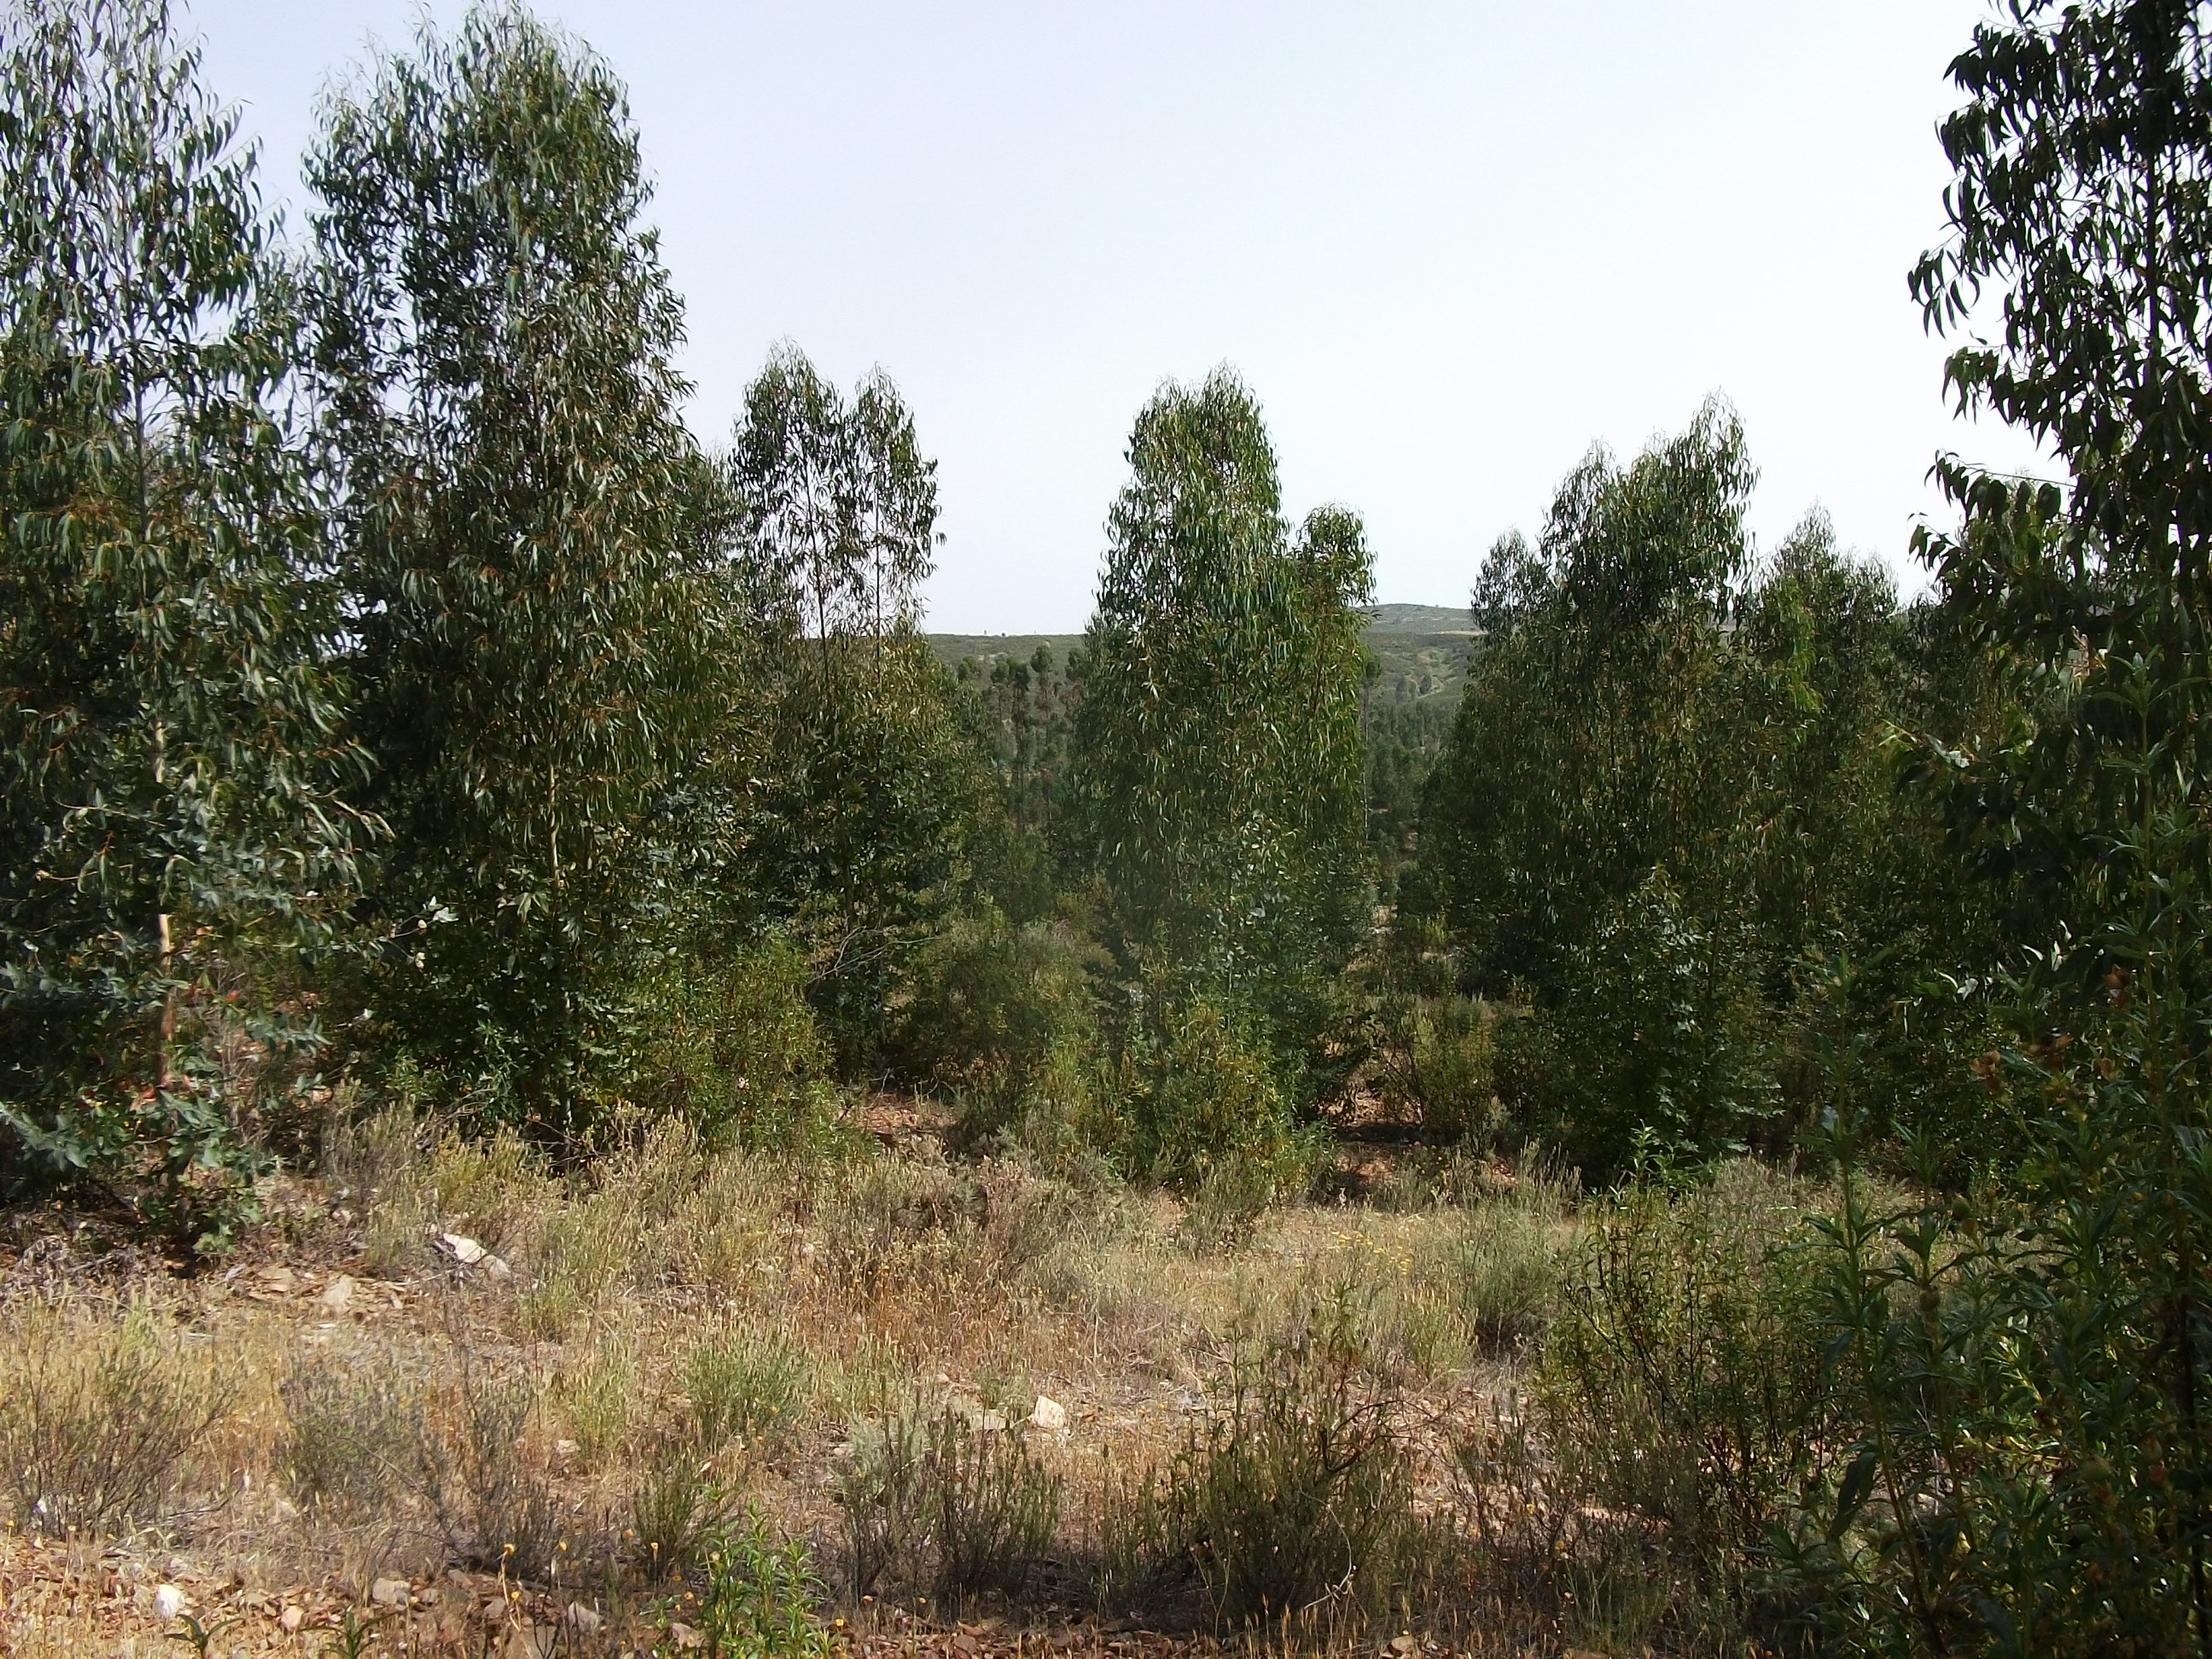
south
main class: Woodland
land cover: Broadleaved woodland
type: exotic forest
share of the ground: 50 - 75 %
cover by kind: broadleaved forest trees 60 %, shrubs 30 %, herbaceous plants 5 %, unconsolidated bare surface 5 %
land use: Forestry
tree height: > 5 m
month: May
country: ES
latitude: 37.7043
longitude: -6.9822
